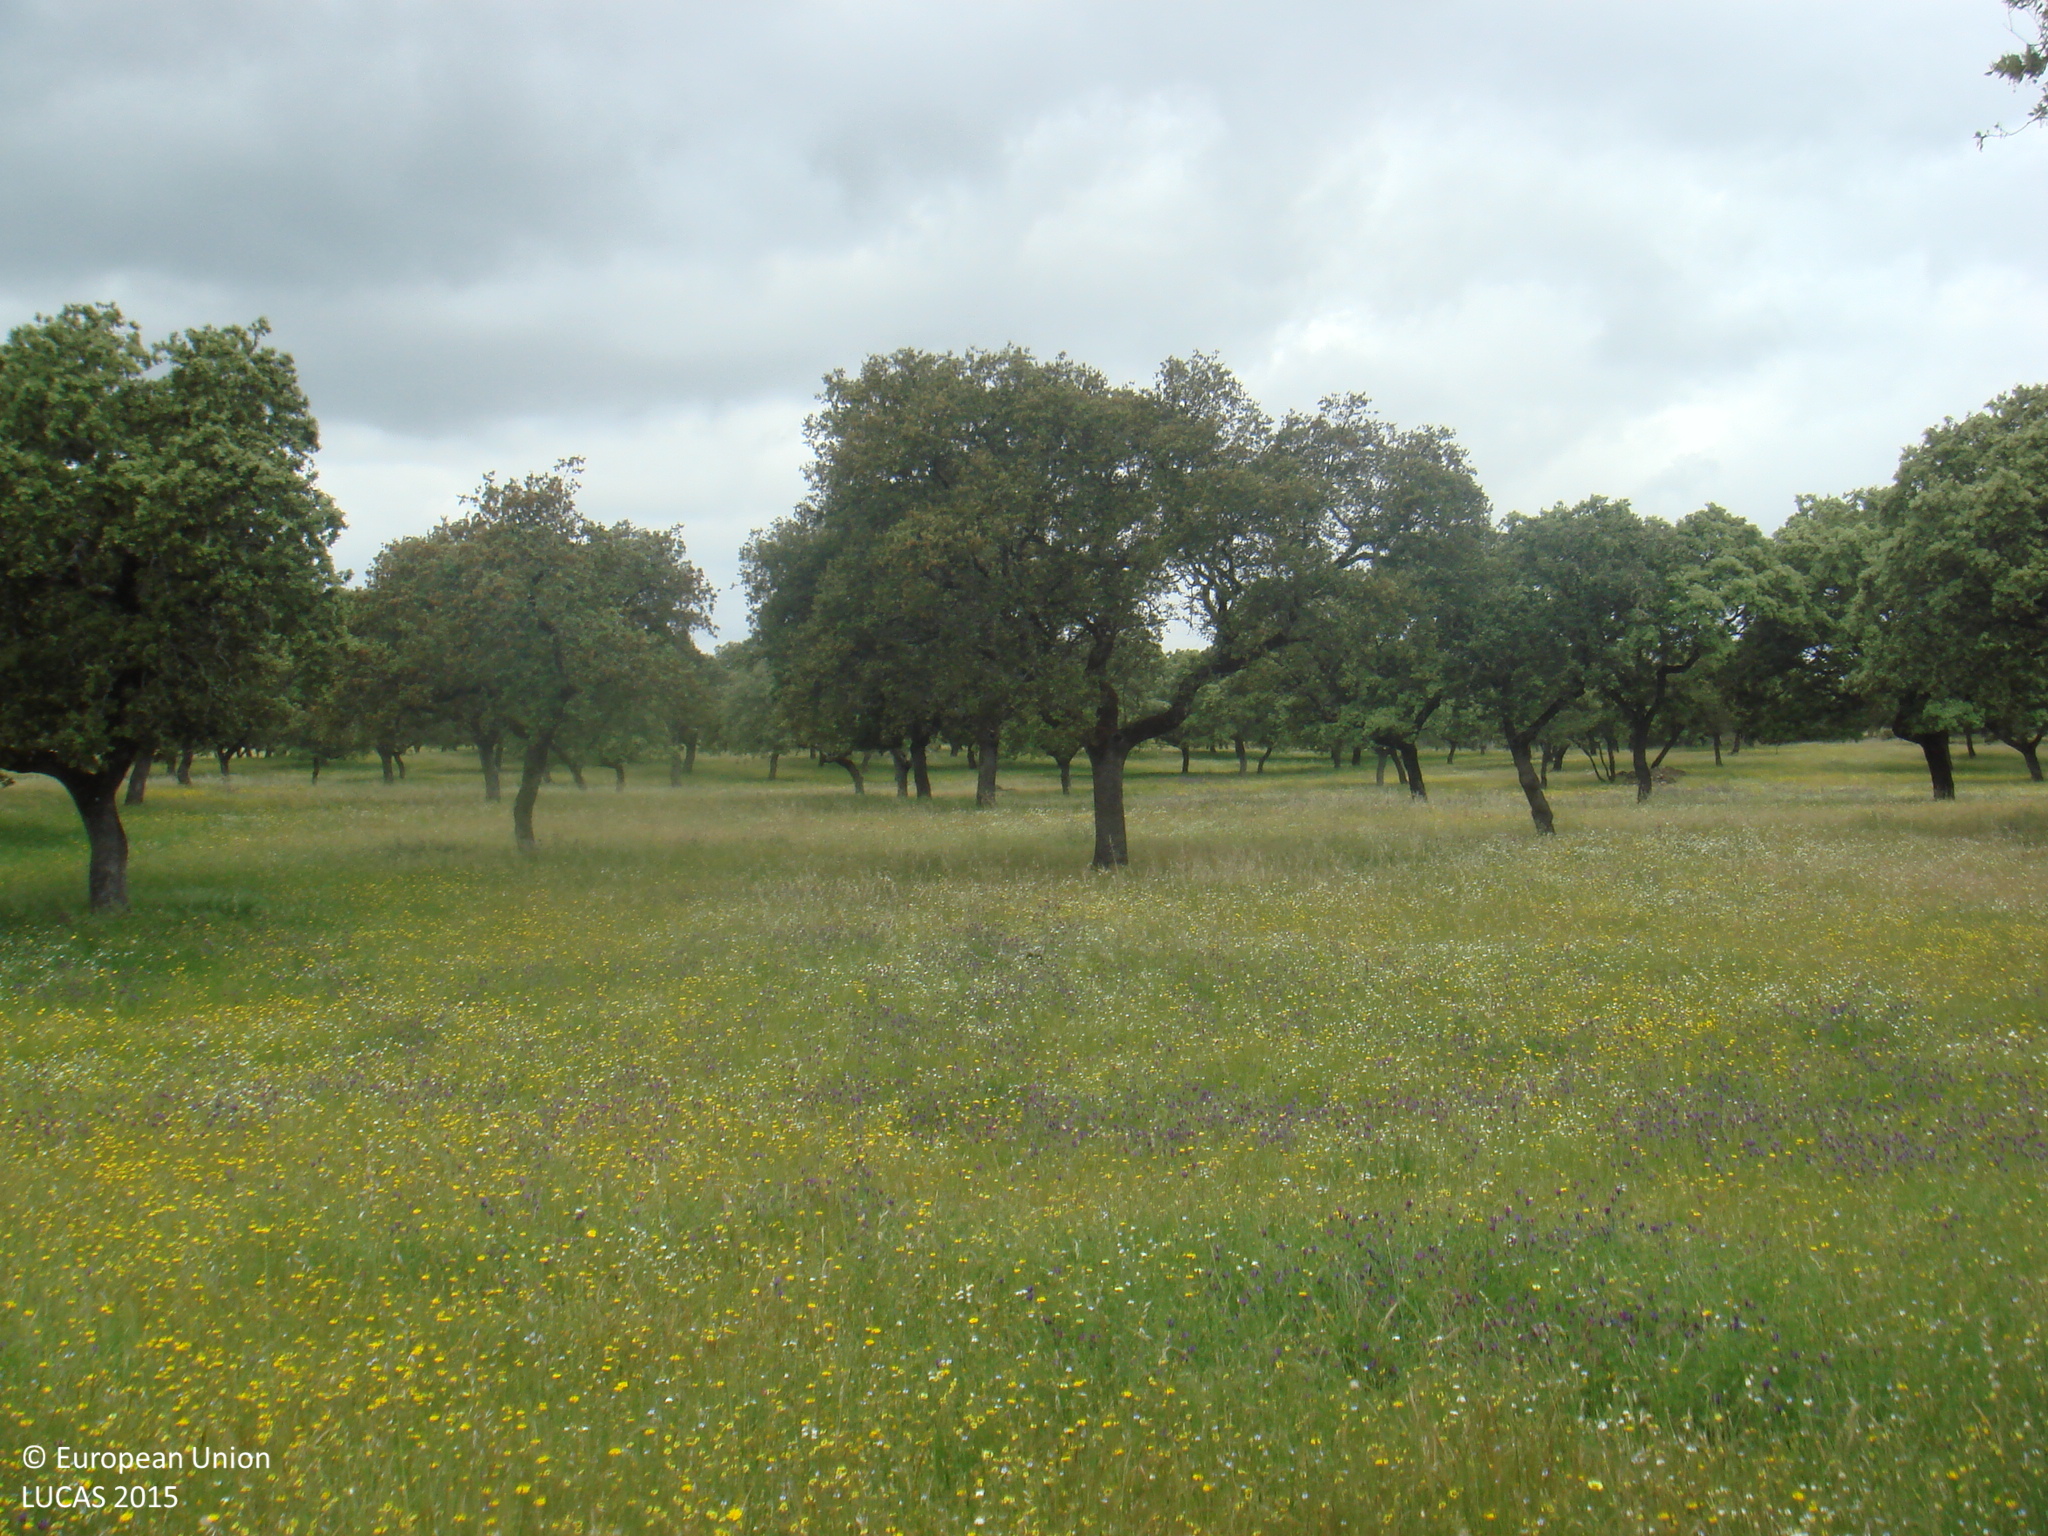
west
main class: Woodland
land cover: Broadleaved woodland
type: broadleaved evergreen forest
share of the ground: 50 - 75 %
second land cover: Grassland without tree/shrub cover
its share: > 75 %
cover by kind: broadleaved forest trees 50 %, herbaceous plants 50 %
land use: Forestry
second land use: Agriculture (excluding fallow land and kitchen gardens)
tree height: > 5 m
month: May
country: ES
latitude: 38.2831
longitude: -4.3858
